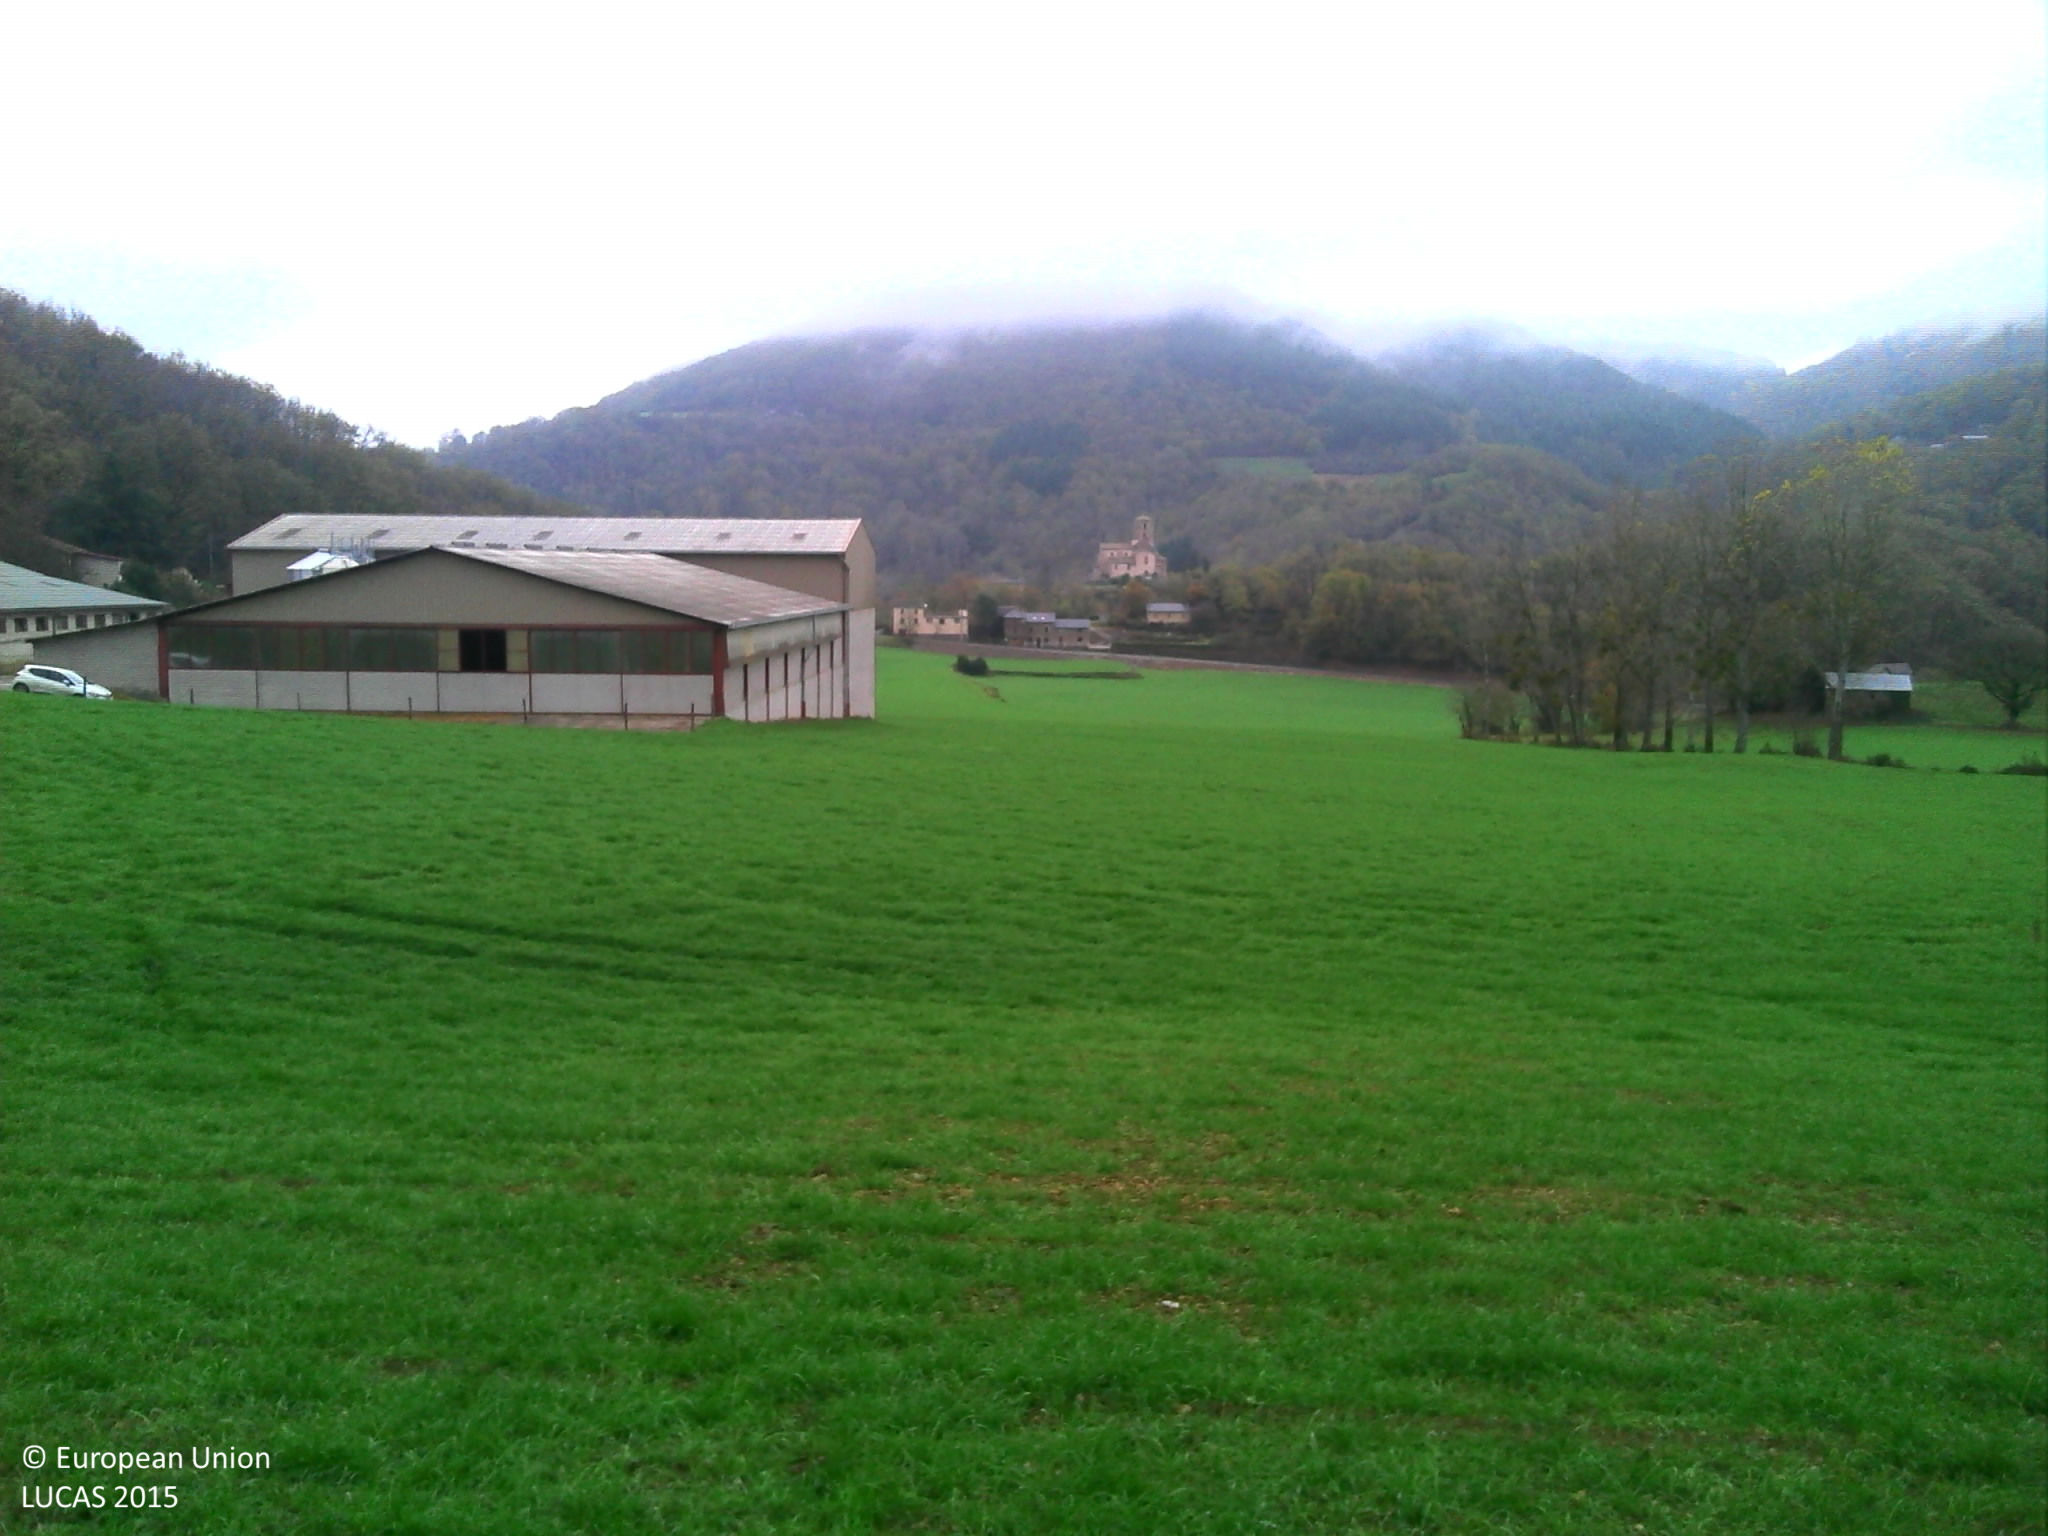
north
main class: Cropland
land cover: Temporary grasslands
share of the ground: > 75 %
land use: Agriculture (excluding fallow land and kitchen gardens)
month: November
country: FR
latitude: 43.9192
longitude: 2.5453
